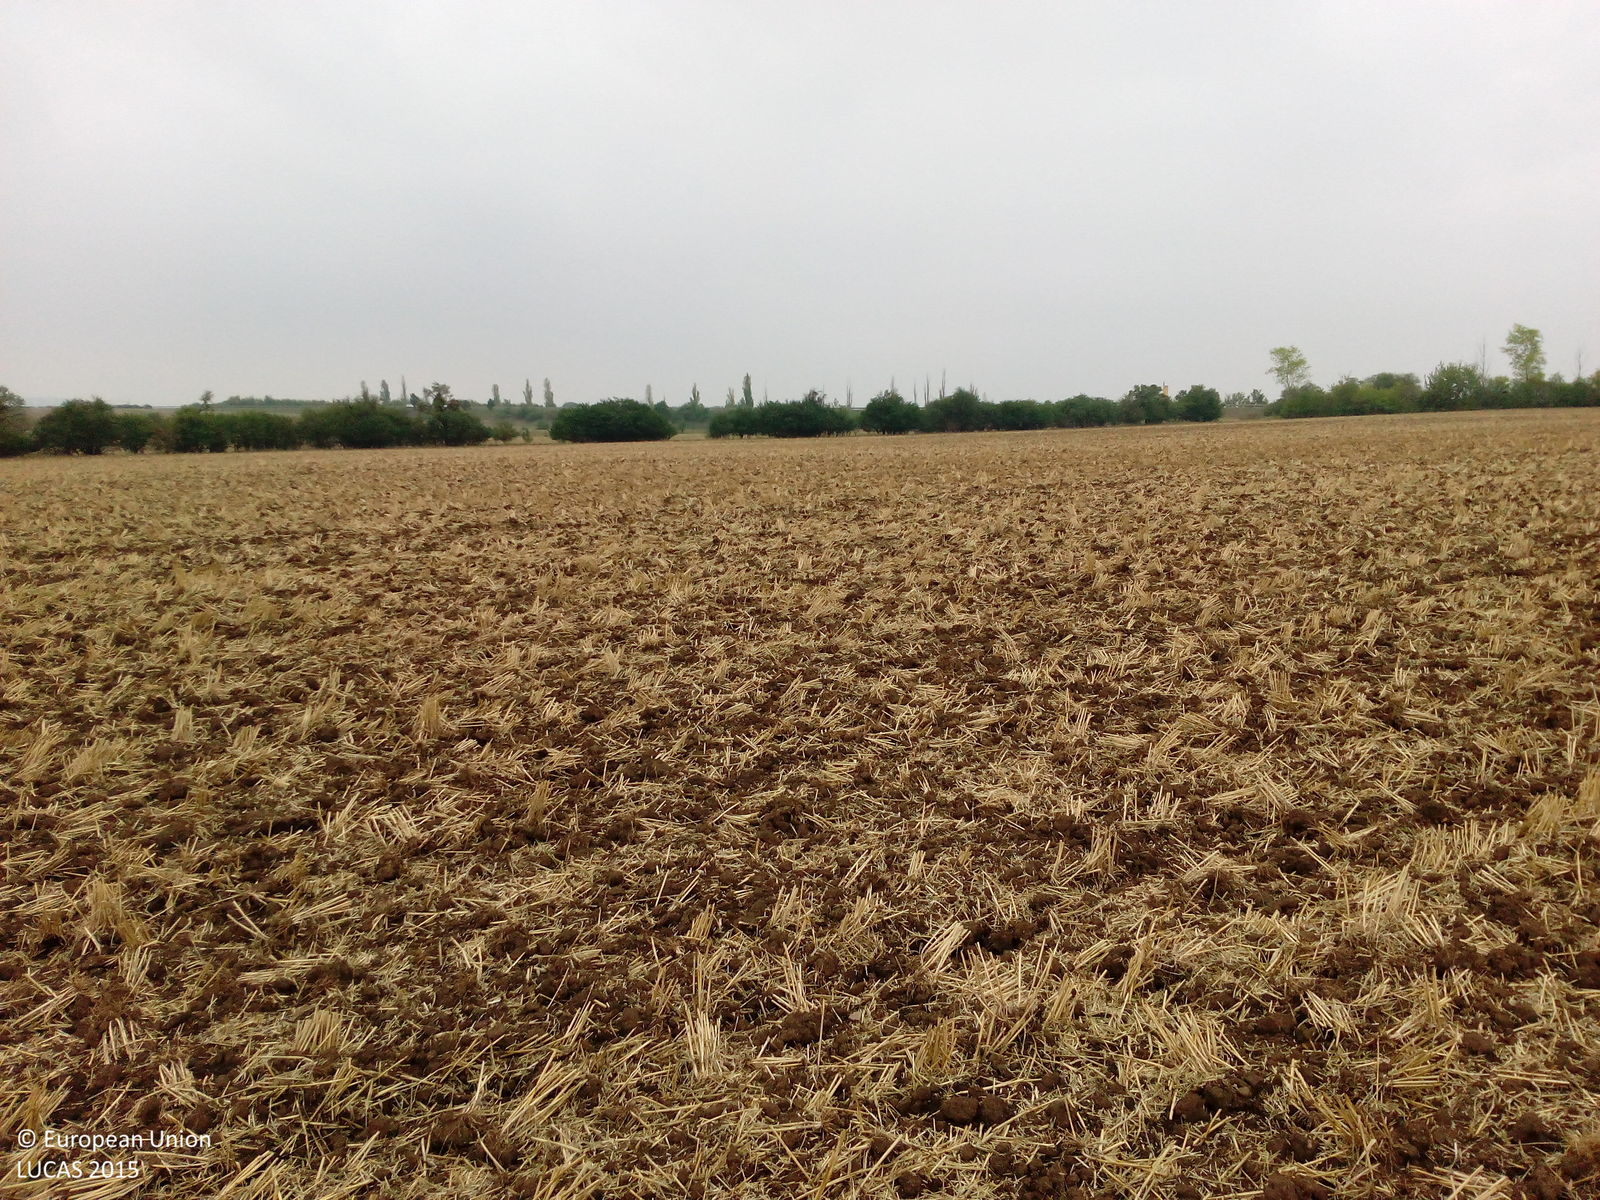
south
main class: Cropland
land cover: Common wheat
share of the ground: < 10 %
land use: Agriculture (excluding fallow land and kitchen gardens)
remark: Harvested field
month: August
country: DE
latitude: 51.0064
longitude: 11.0686
